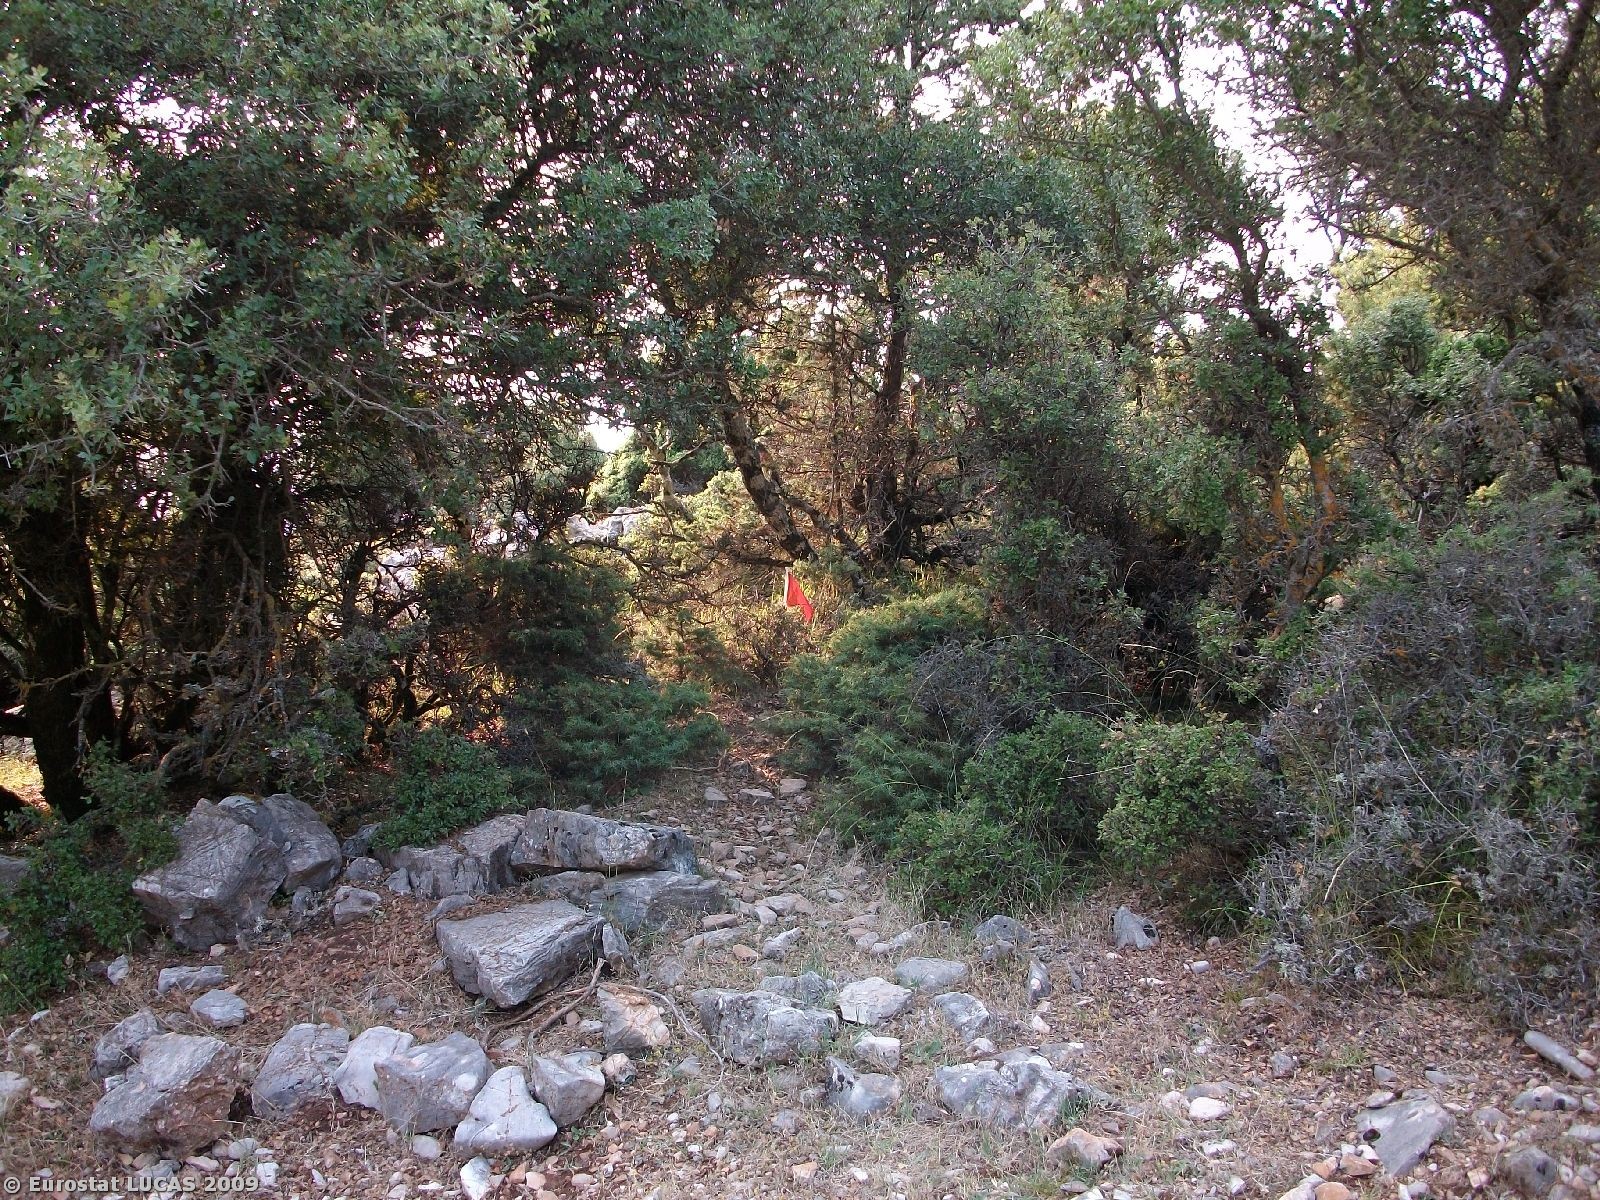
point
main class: Woodland
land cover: Broadleaved woodland
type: thermophilous deciduous forest
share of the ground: > 75 %
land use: Forestry
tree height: > 5 m
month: August
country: GR
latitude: 38.9562
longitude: 21.5954
